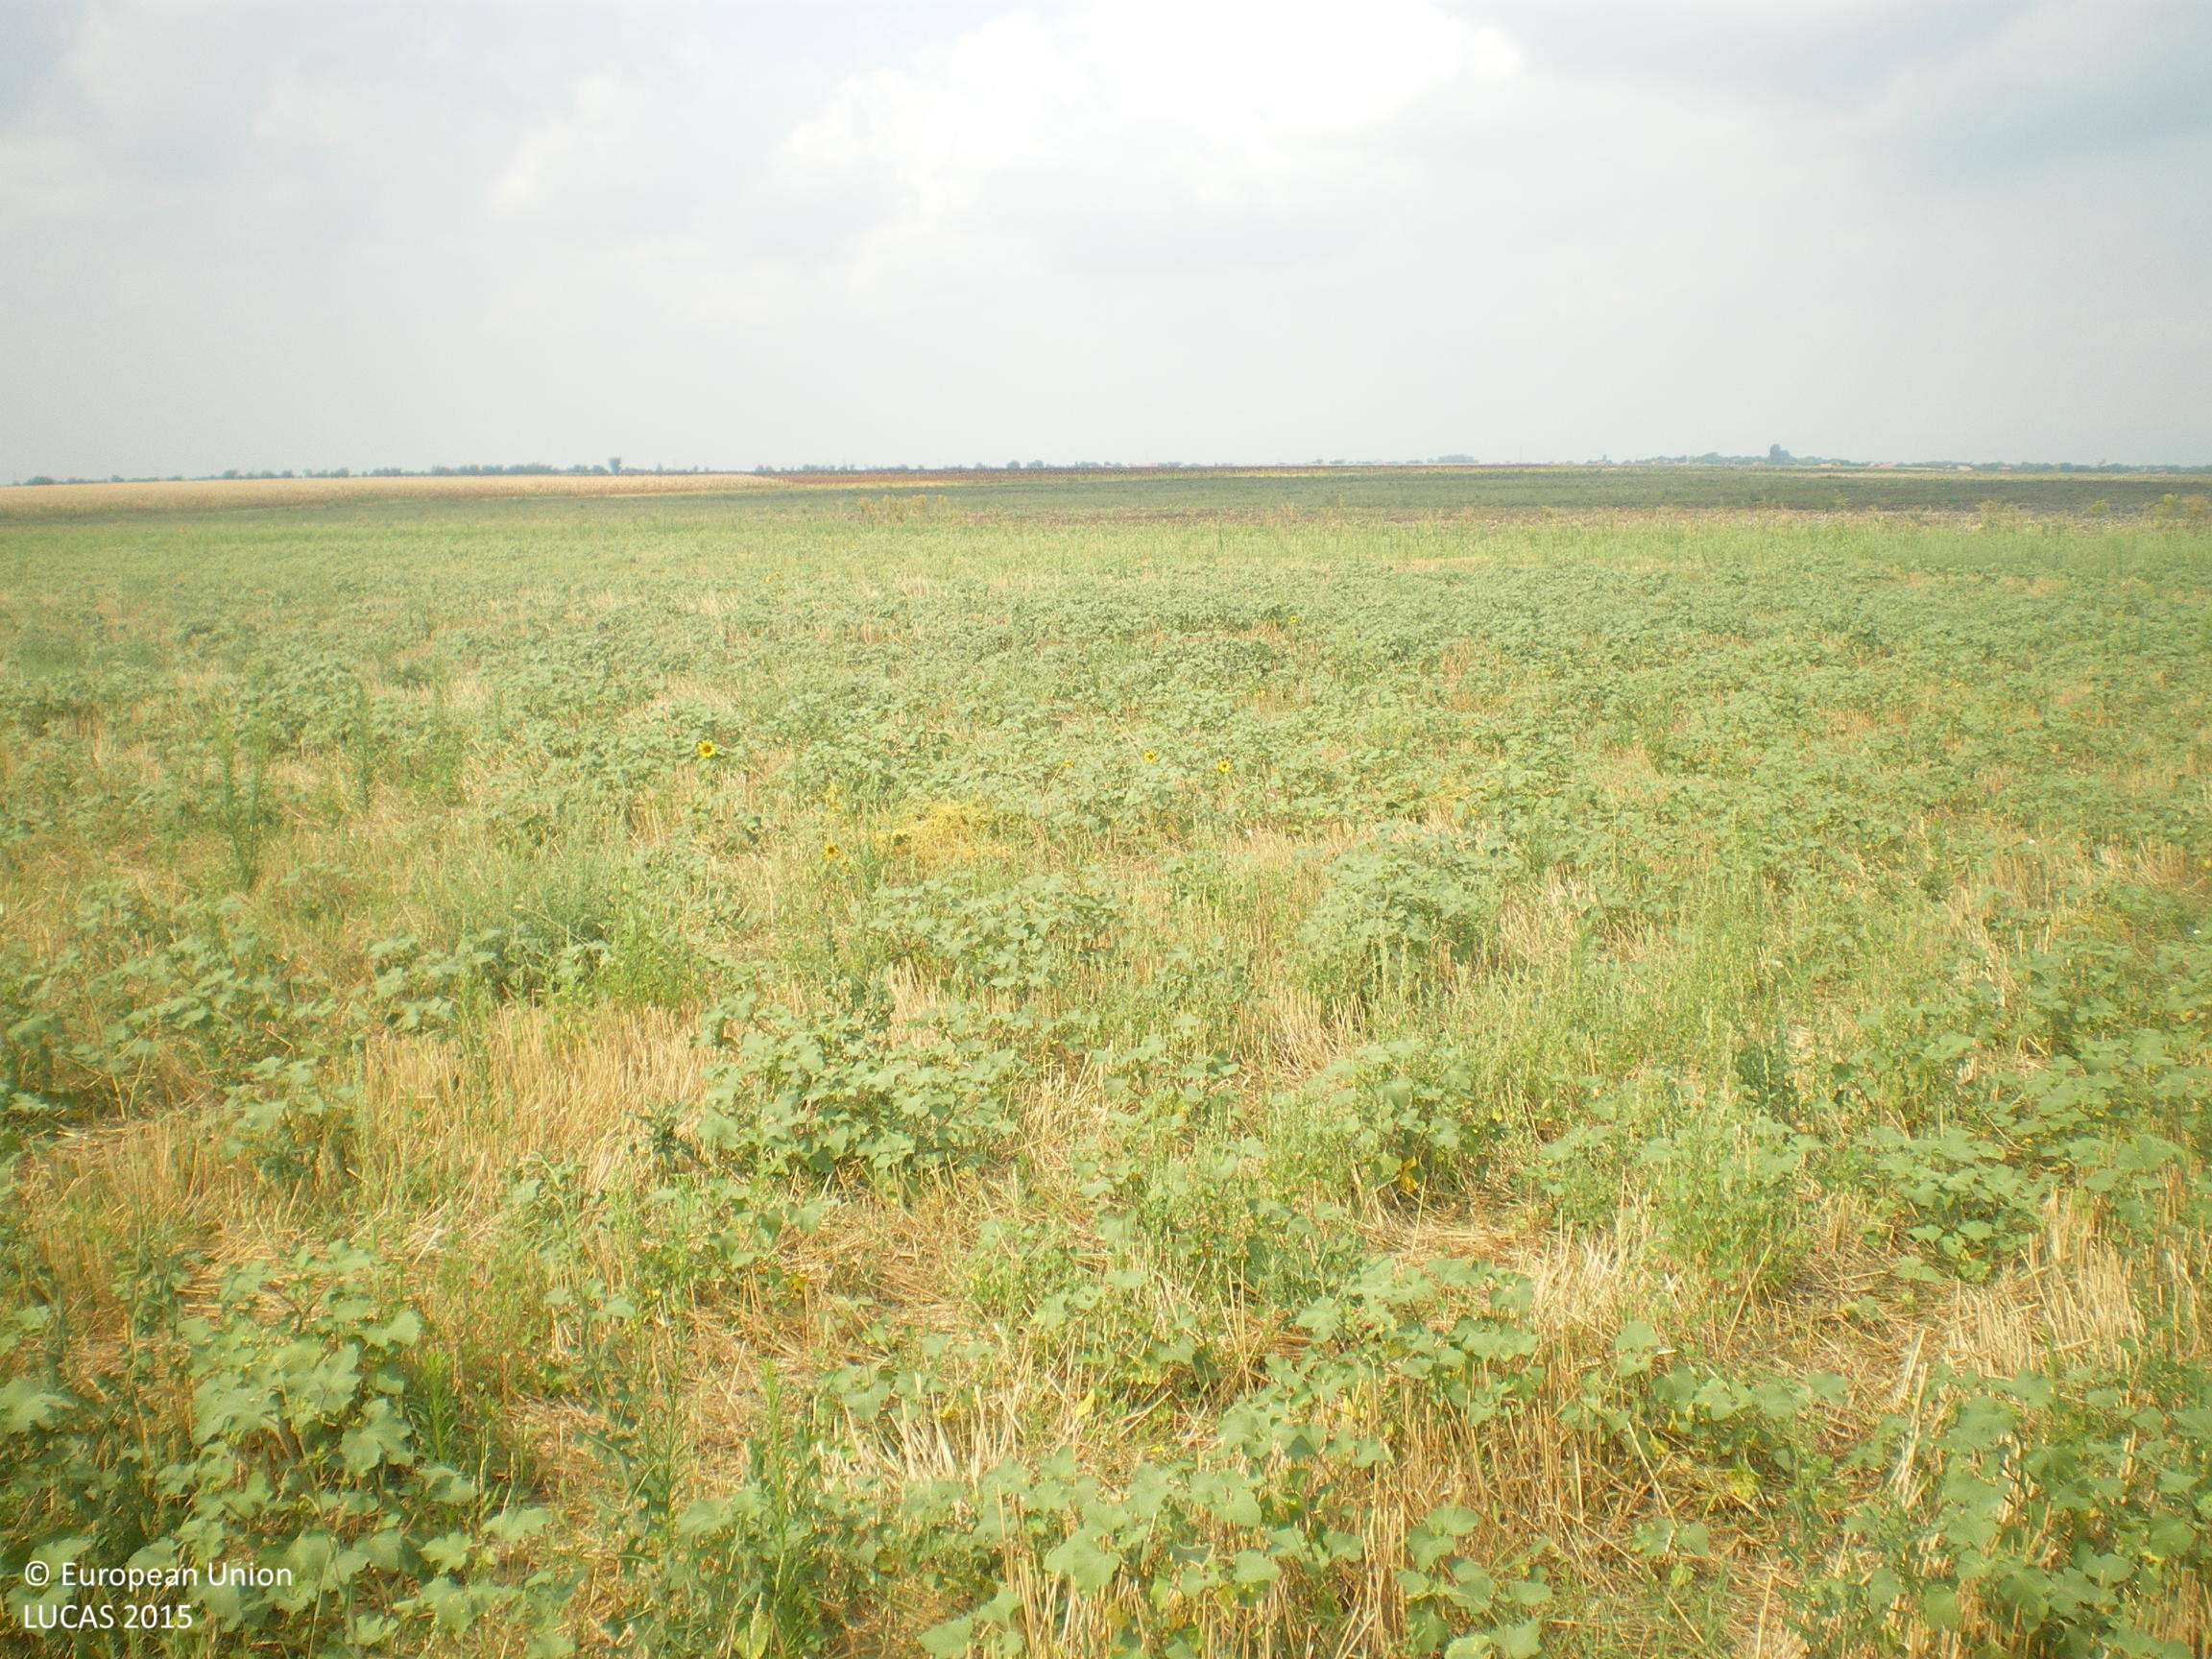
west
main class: Cropland
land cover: Common wheat
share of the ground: < 10 %
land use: Agriculture (excluding fallow land and kitchen gardens)
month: August
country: BG
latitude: 42.3488
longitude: 25.8693
